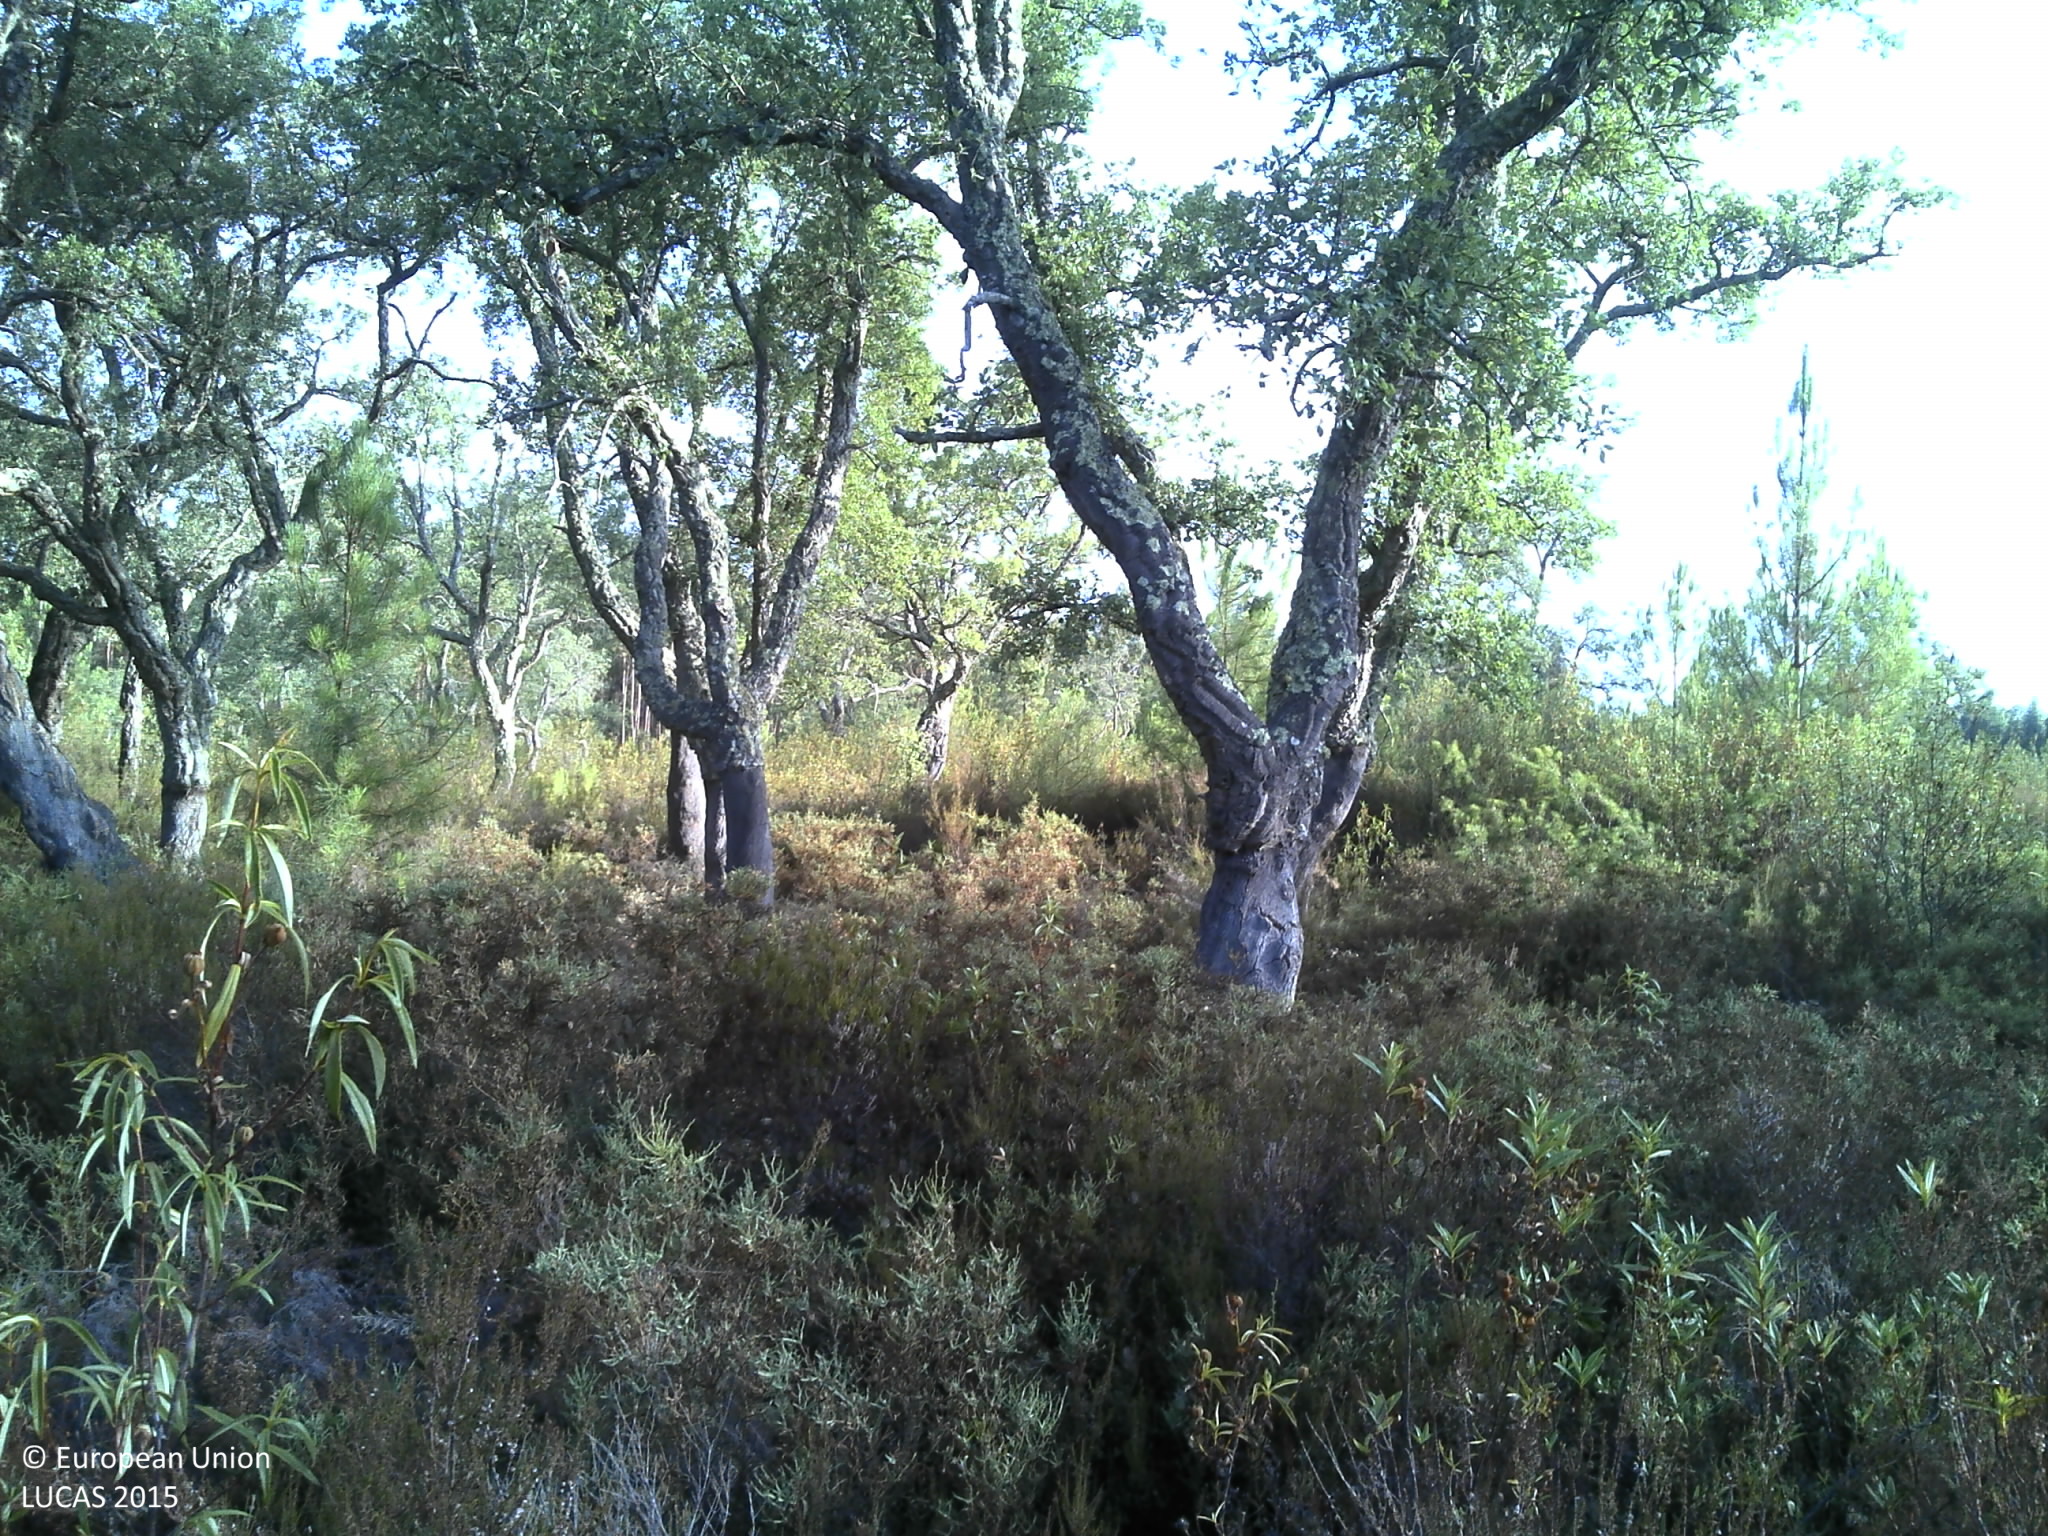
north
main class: Woodland
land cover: Broadleaved woodland
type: broadleaved evergreen forest
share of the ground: 10 - 25 %
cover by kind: shrubs 85 %, broadleaved forest trees 15 %
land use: Forestry
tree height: > 5 m
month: July
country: PT
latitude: 39.4175
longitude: -7.9080
